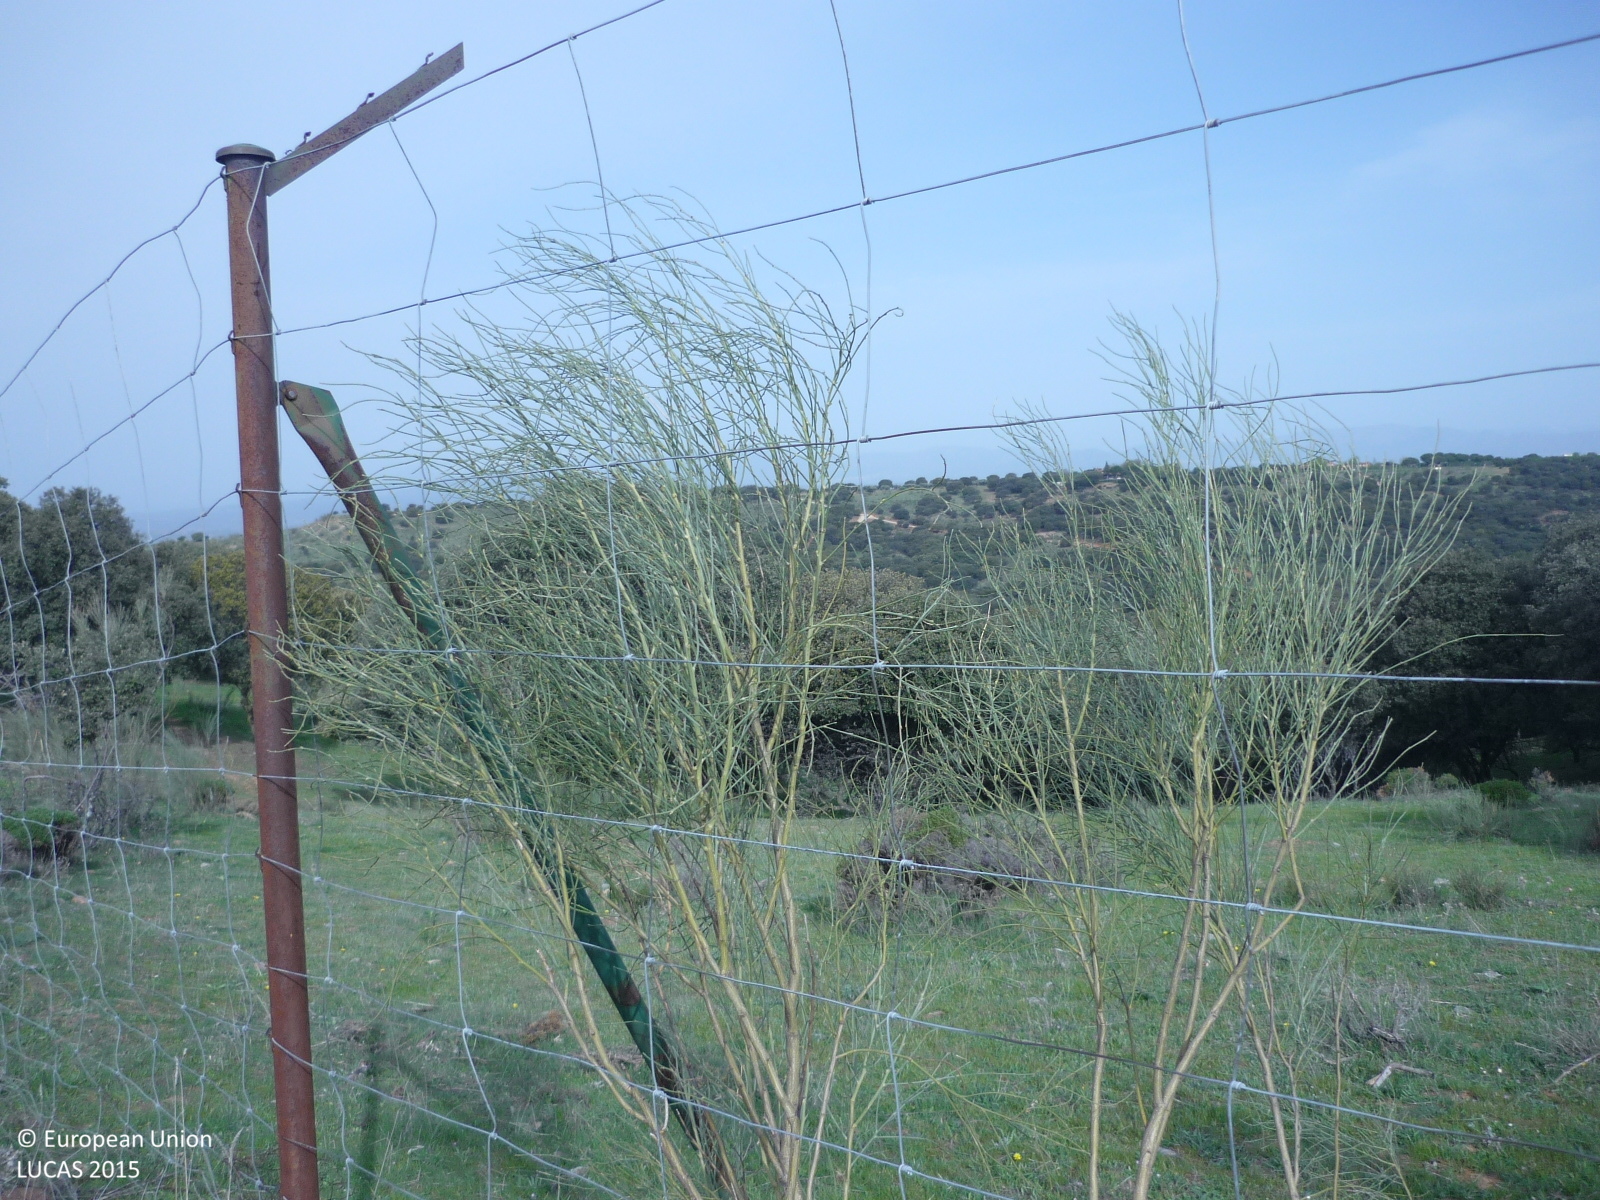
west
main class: Woodland
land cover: Broadleaved woodland
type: broadleaved evergreen forest
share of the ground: 50 - 75 %
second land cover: Grassland without tree/shrub cover
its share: > 75 %
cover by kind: broadleaved forest trees 60 %, herbaceous plants 25 %, unconsolidated bare surface 10 %, shrubs 5 %
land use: Forestry
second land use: Agriculture (excluding fallow land and kitchen gardens)
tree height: < 5 m
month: April
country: ES
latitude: 40.6597
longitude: -3.4142
